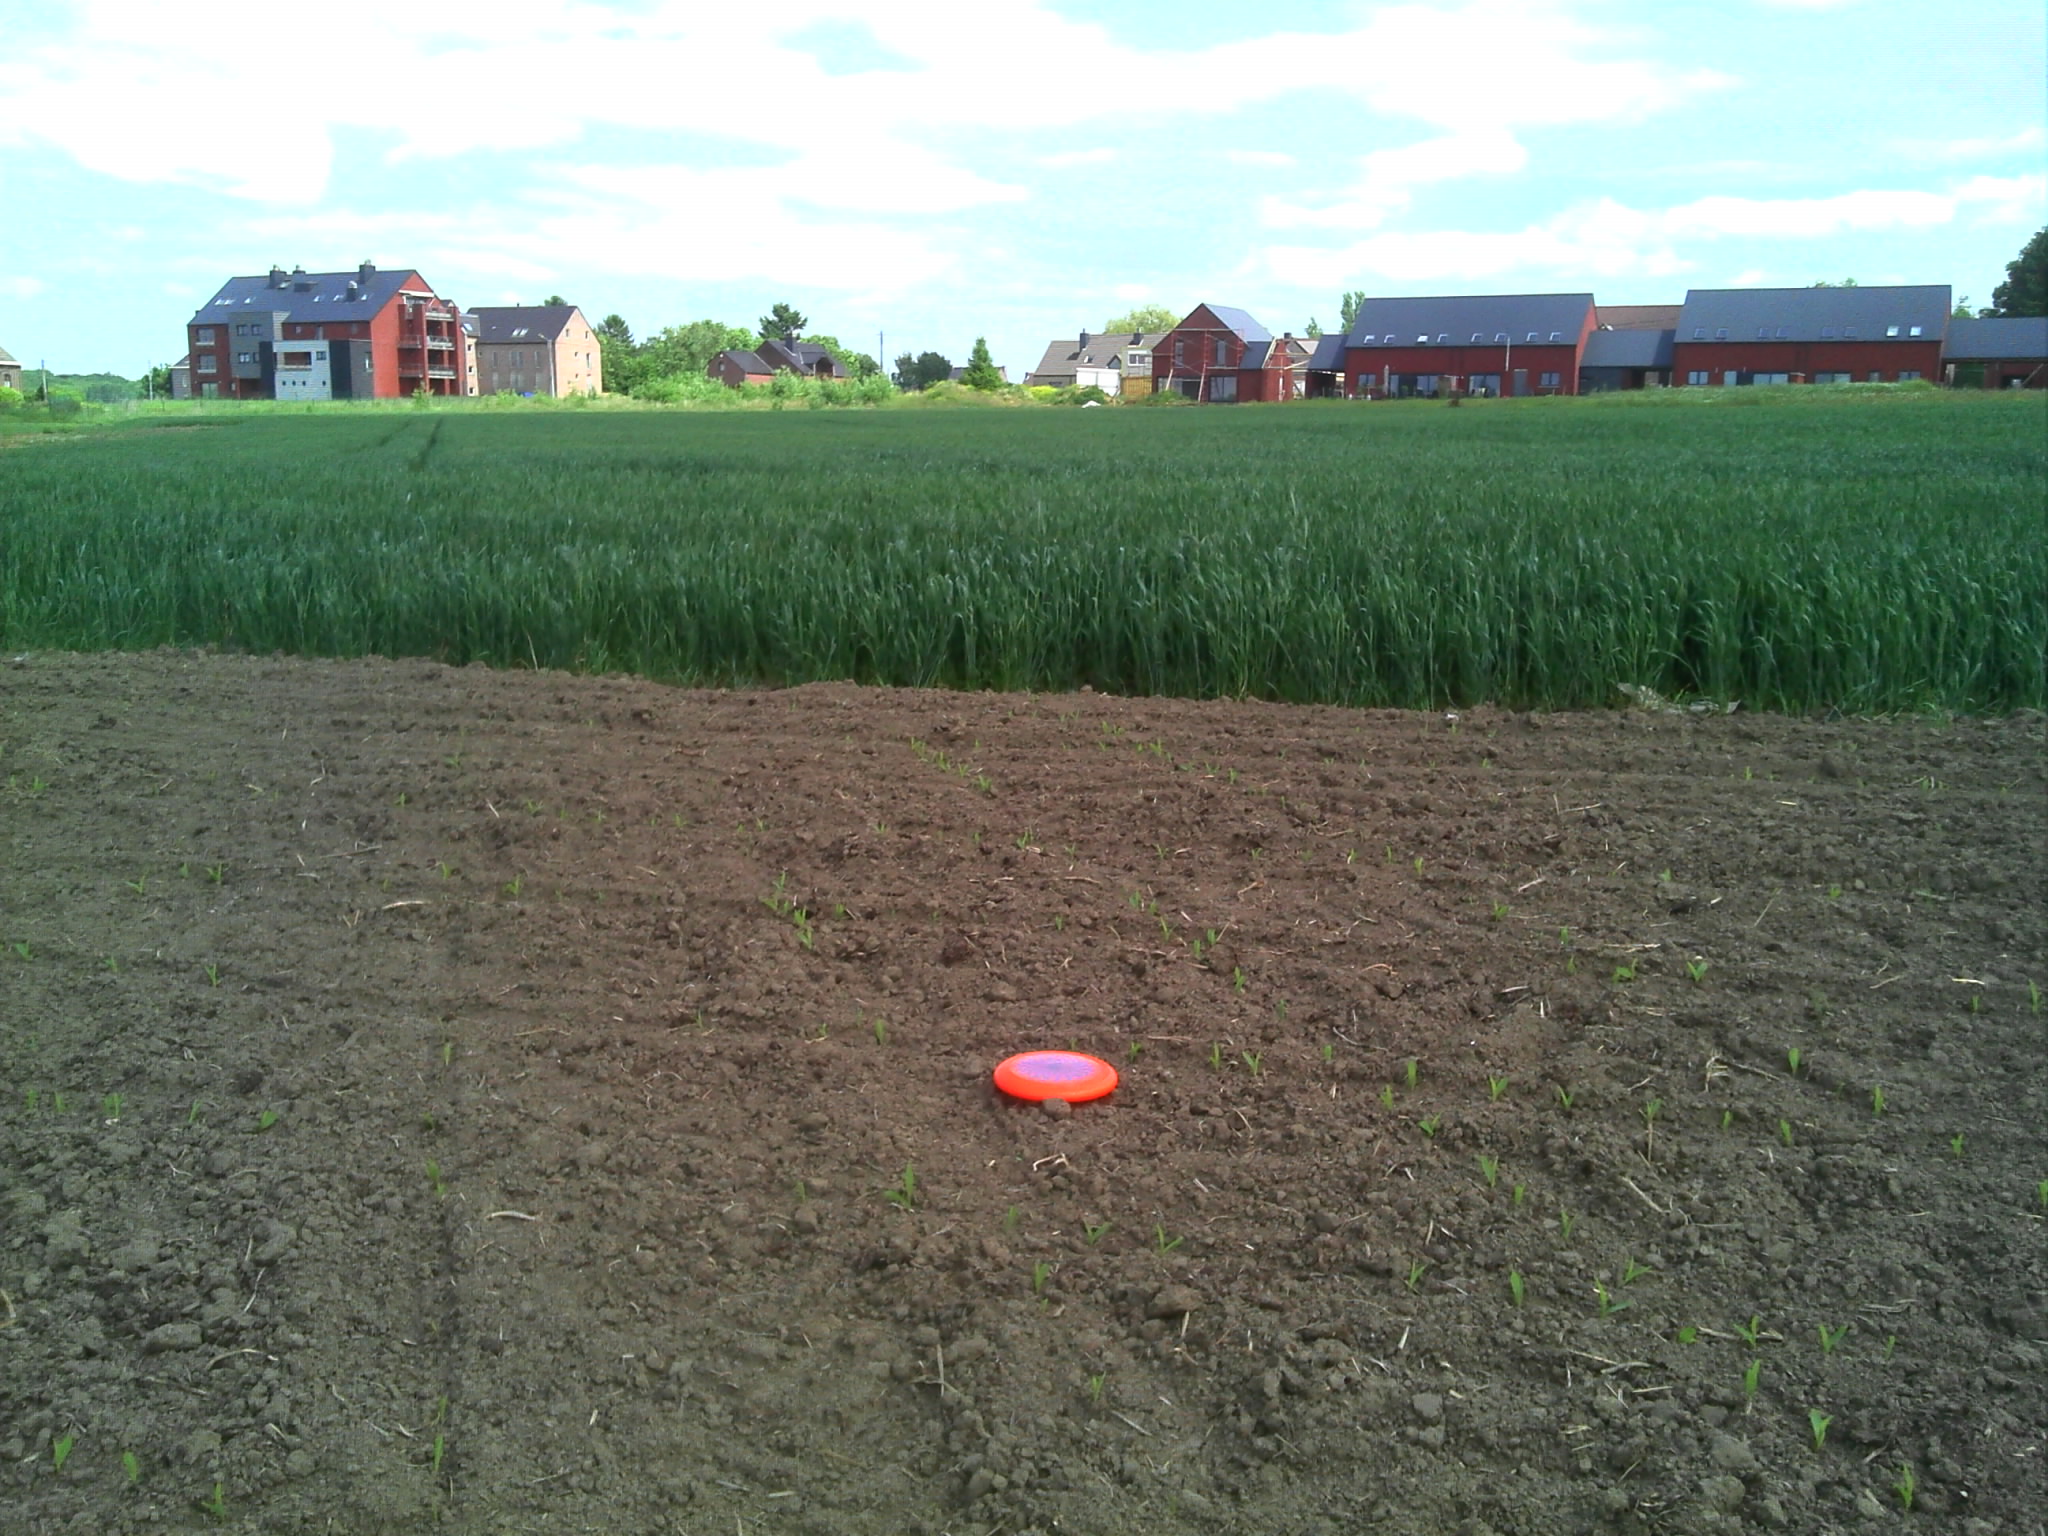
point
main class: Cropland
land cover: Maize
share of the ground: < 10 %
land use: Agriculture (excluding fallow land and kitchen gardens)
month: June
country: BE
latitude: 50.4721
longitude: 4.6279
